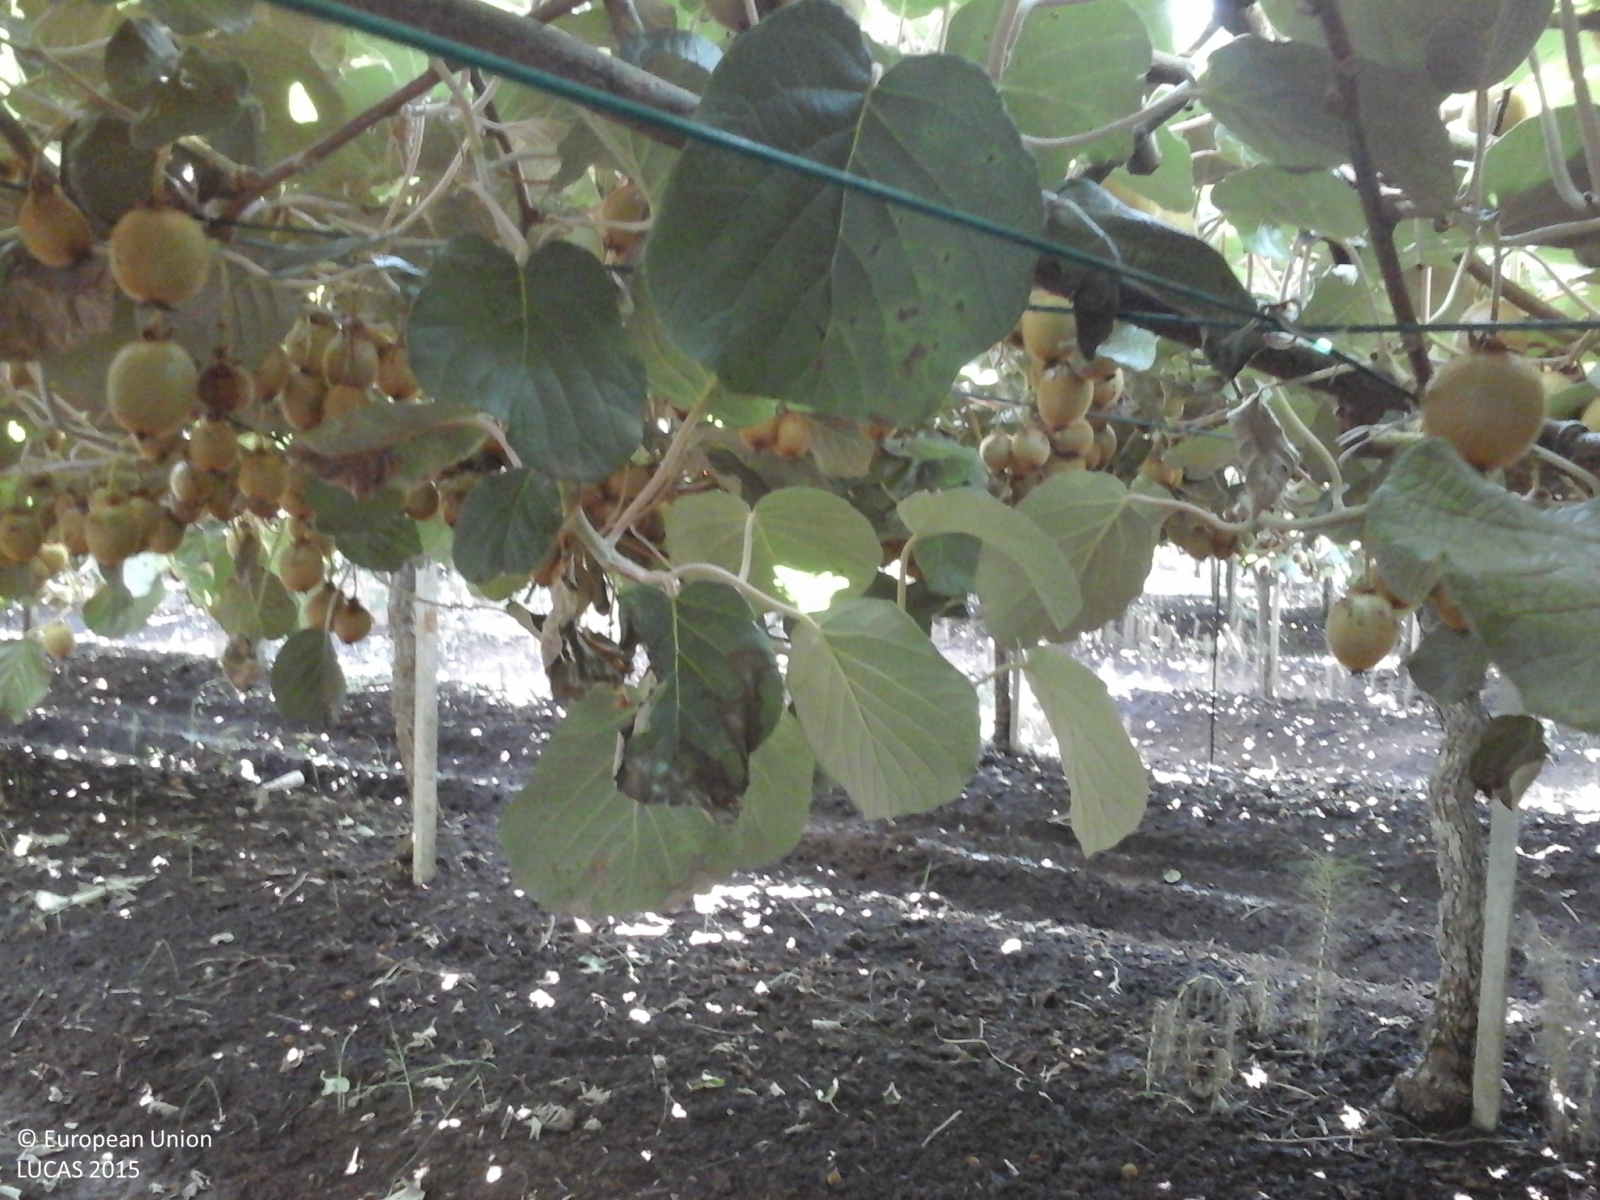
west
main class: Cropland
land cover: Other fruit trees and berries
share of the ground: > 75 %
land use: Agriculture (excluding fallow land and kitchen gardens)
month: July
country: IT
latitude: 41.5819
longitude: 12.9033
